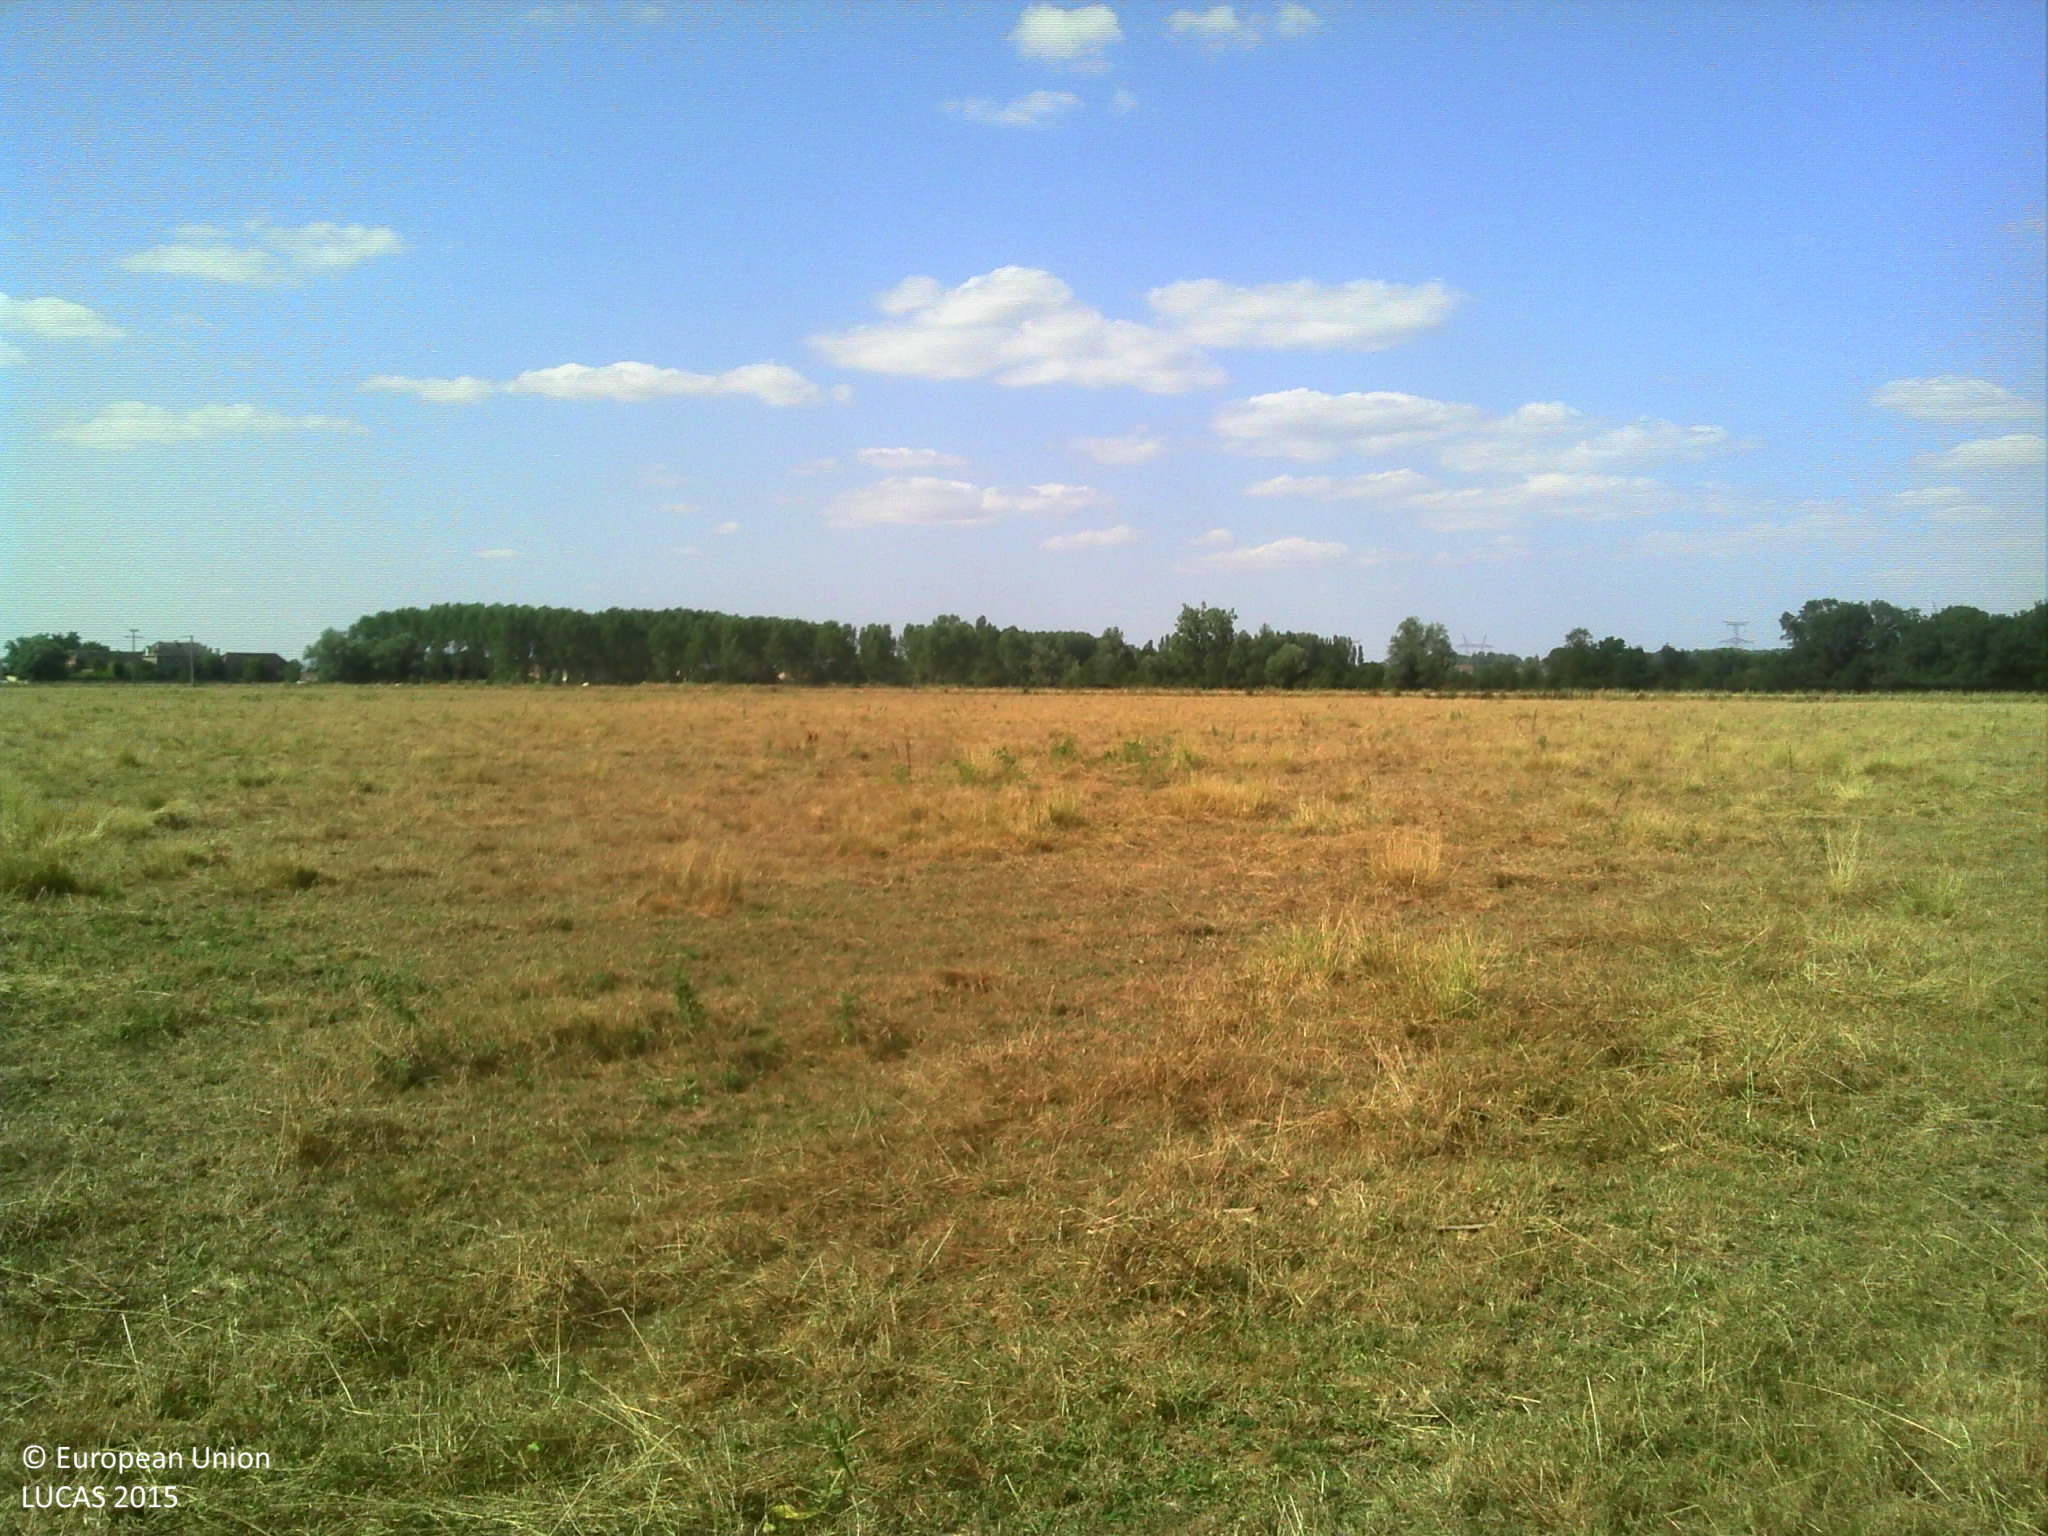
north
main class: Cropland
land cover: Maize
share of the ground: > 75 %
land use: Agriculture (excluding fallow land and kitchen gardens)
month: July
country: FR
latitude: 46.9390
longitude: 5.0226
